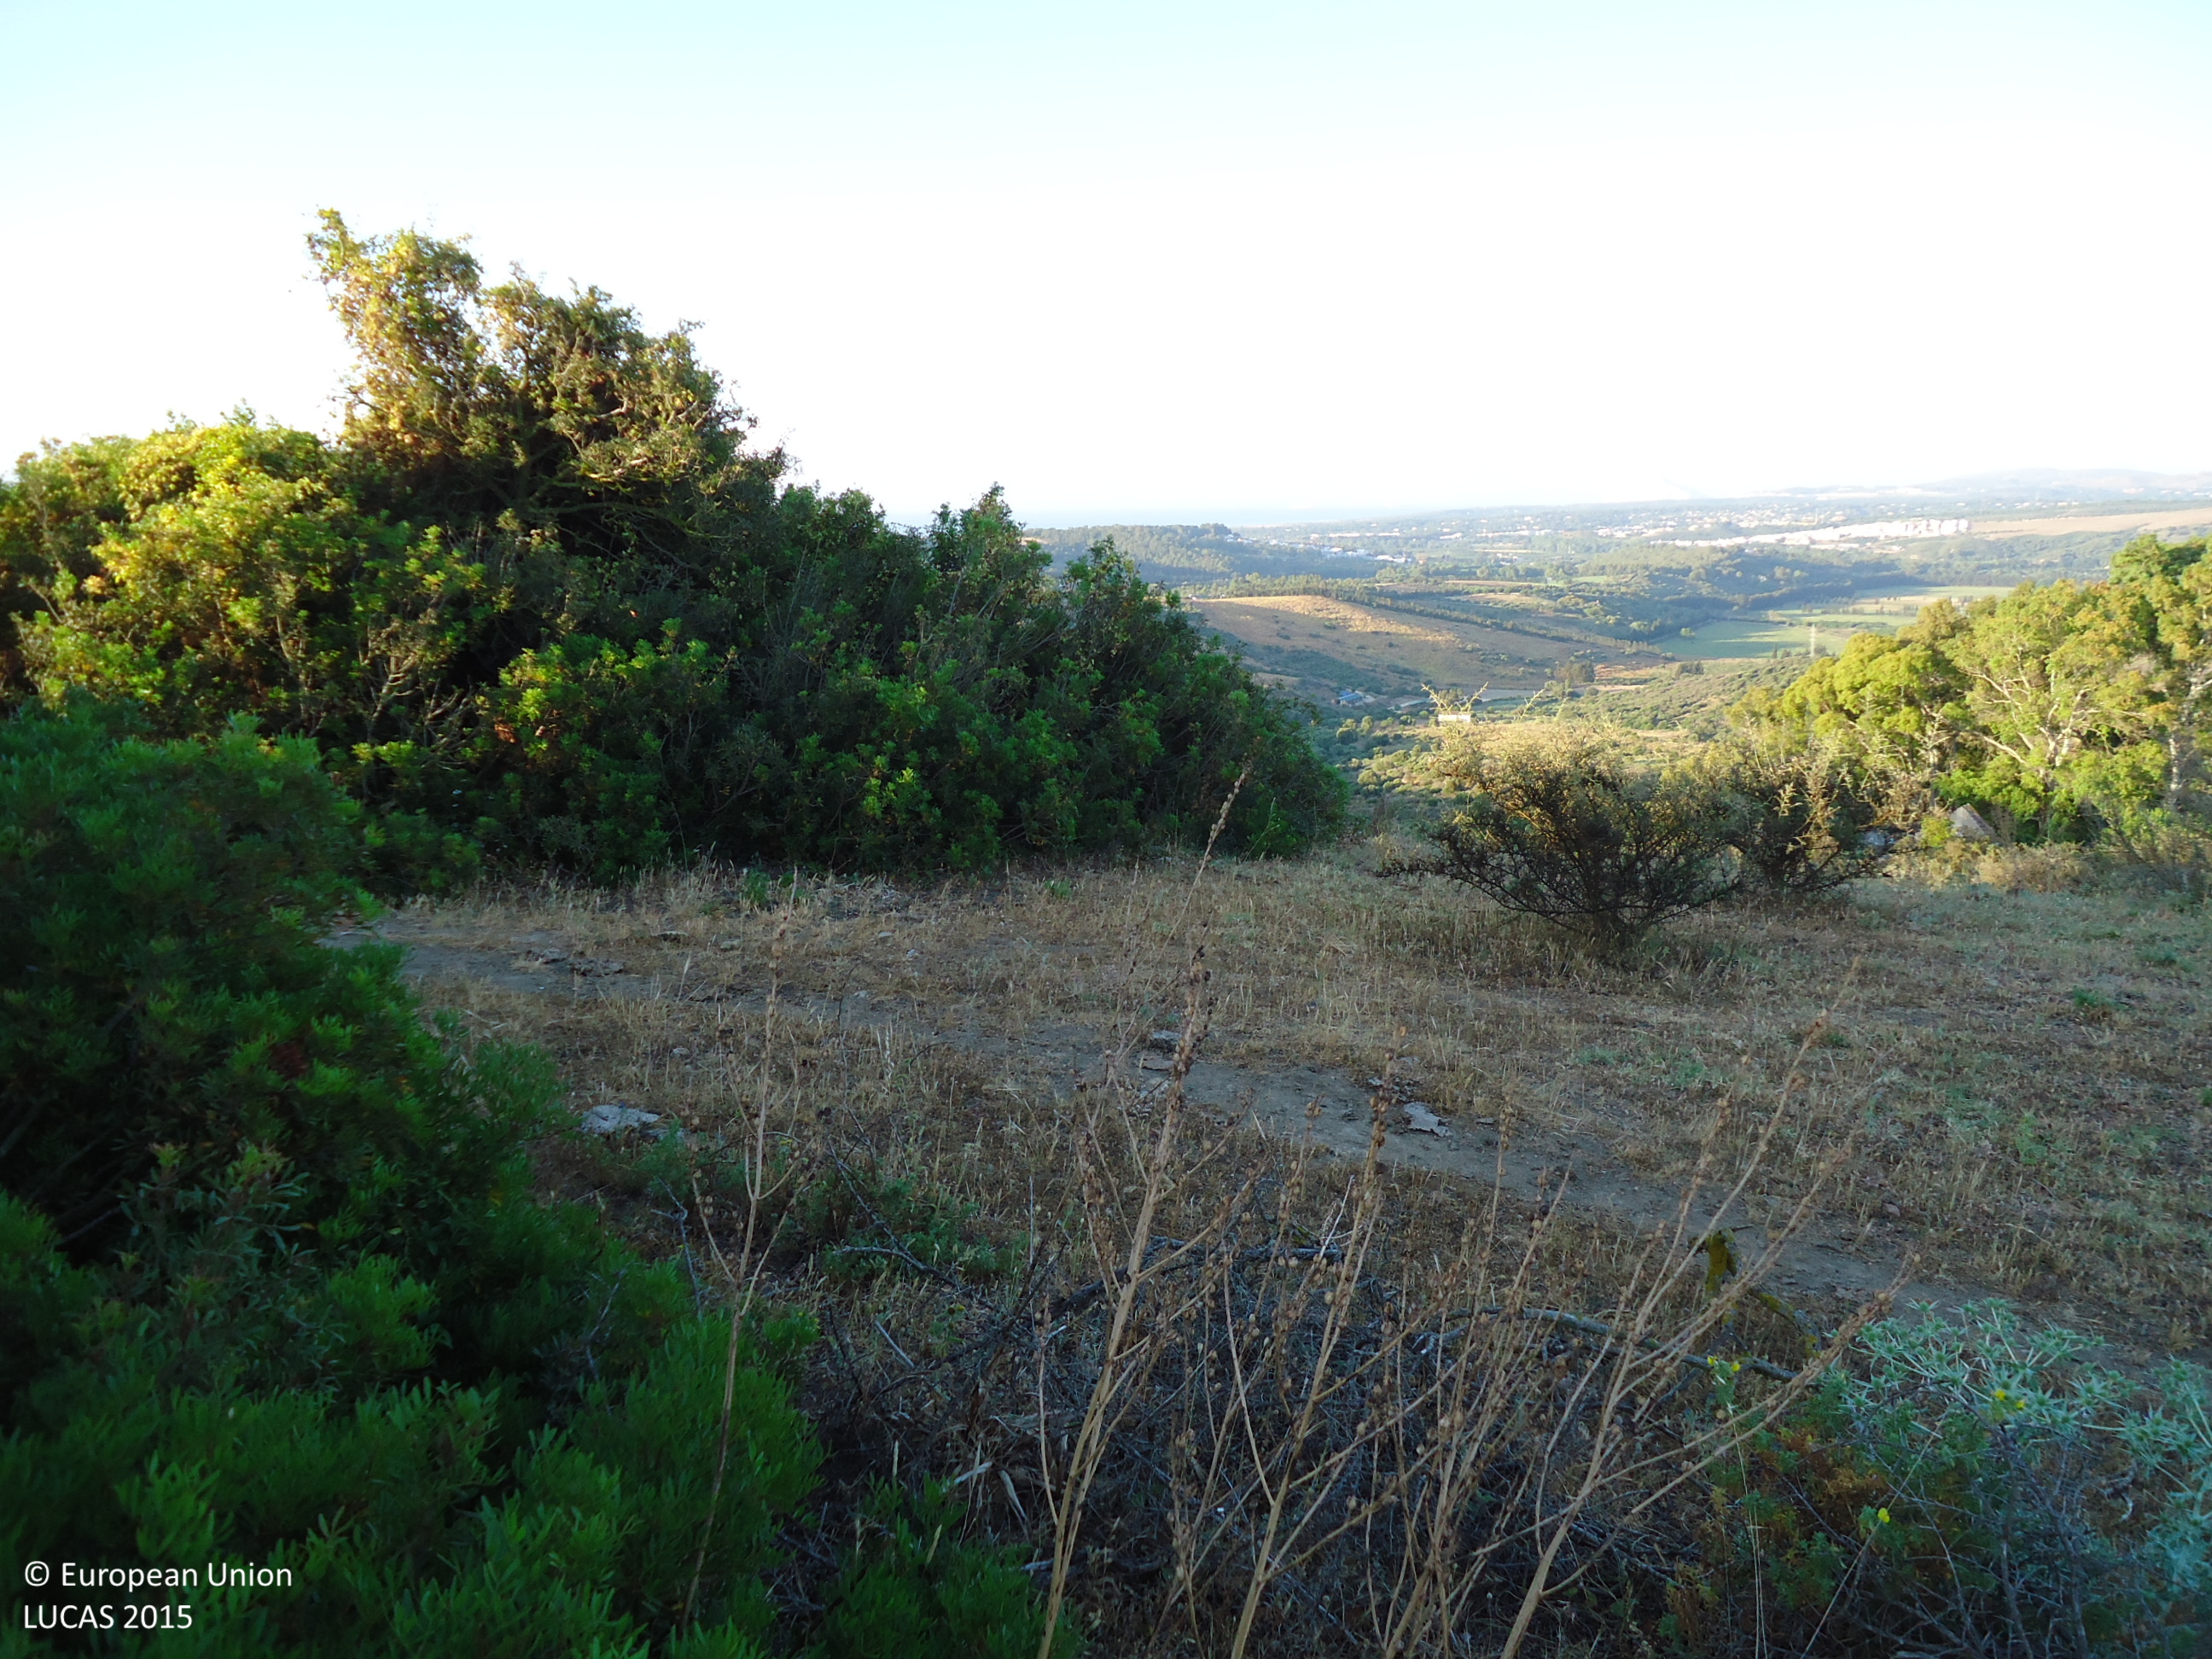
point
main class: Shrubland
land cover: Shrubland without tree cover
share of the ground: 25 - 50 %
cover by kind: herbaceous plants 60 %, shrubs 40 %
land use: Agriculture (excluding fallow land and kitchen gardens)
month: June
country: ES
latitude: 36.3373
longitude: -5.2898
